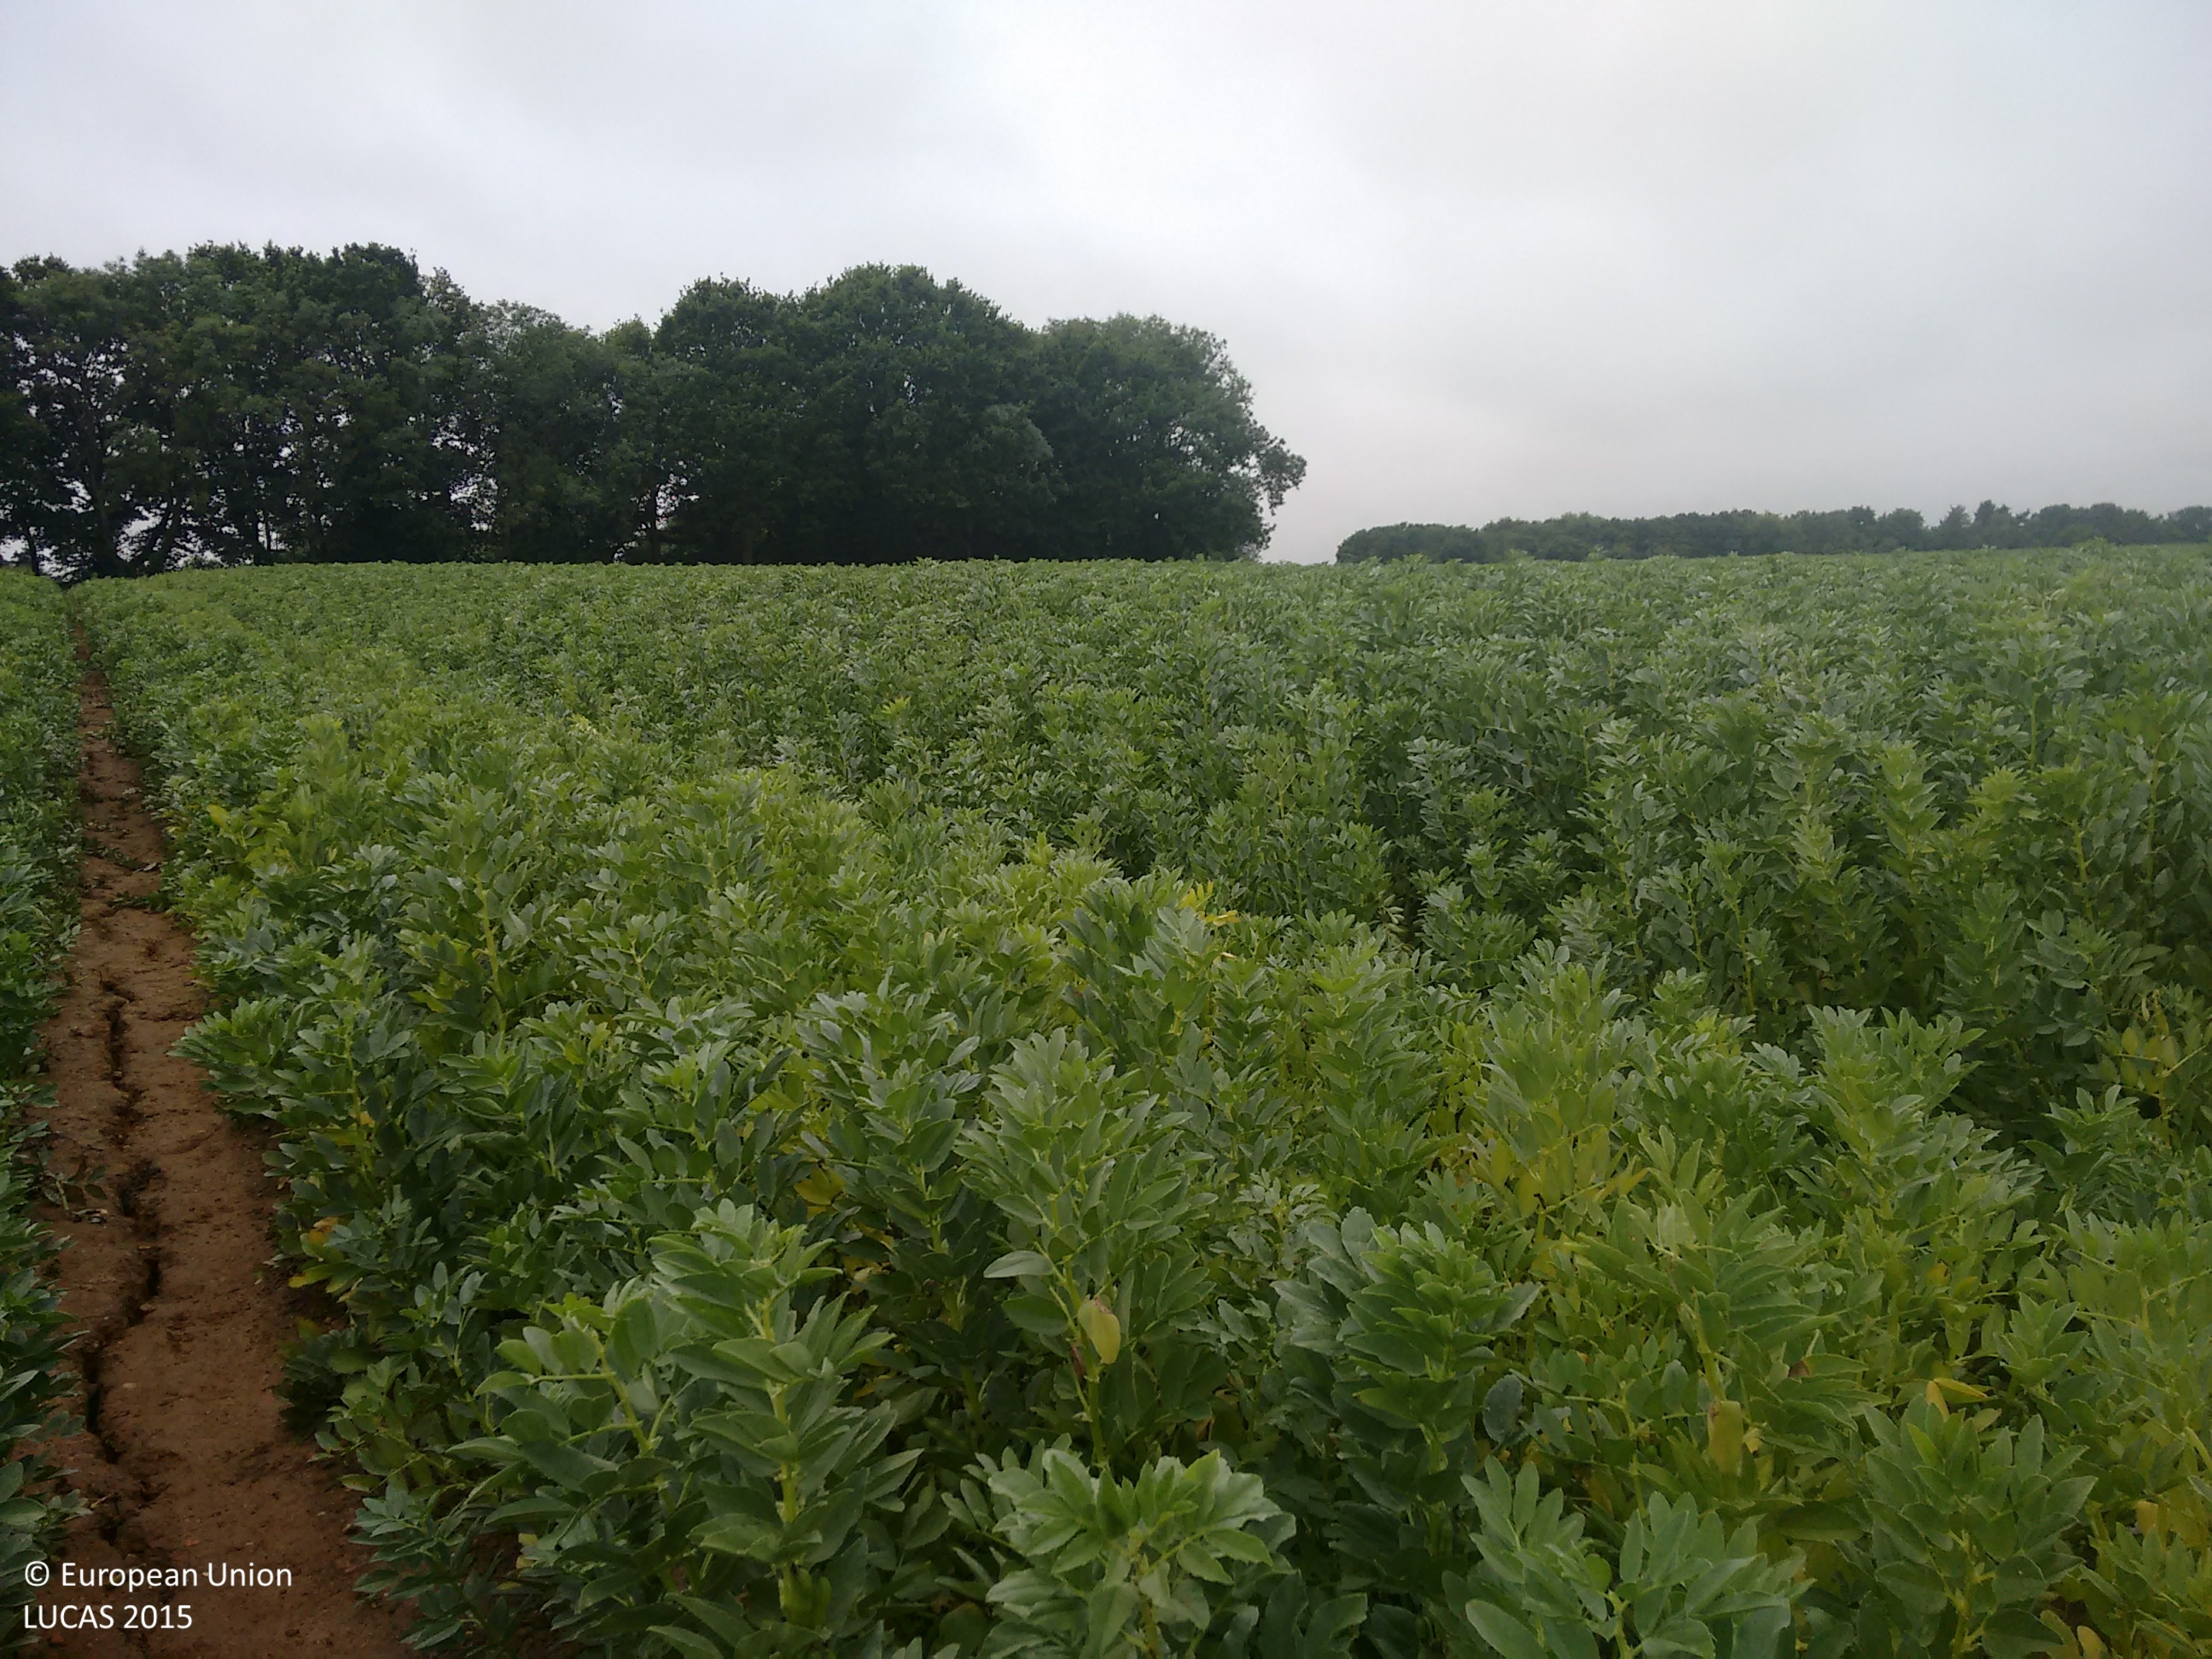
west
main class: Cropland
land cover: Dry pulses
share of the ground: > 75 %
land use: Agriculture (excluding fallow land and kitchen gardens)
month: July
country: GB
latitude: 51.6582
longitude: 0.3577
